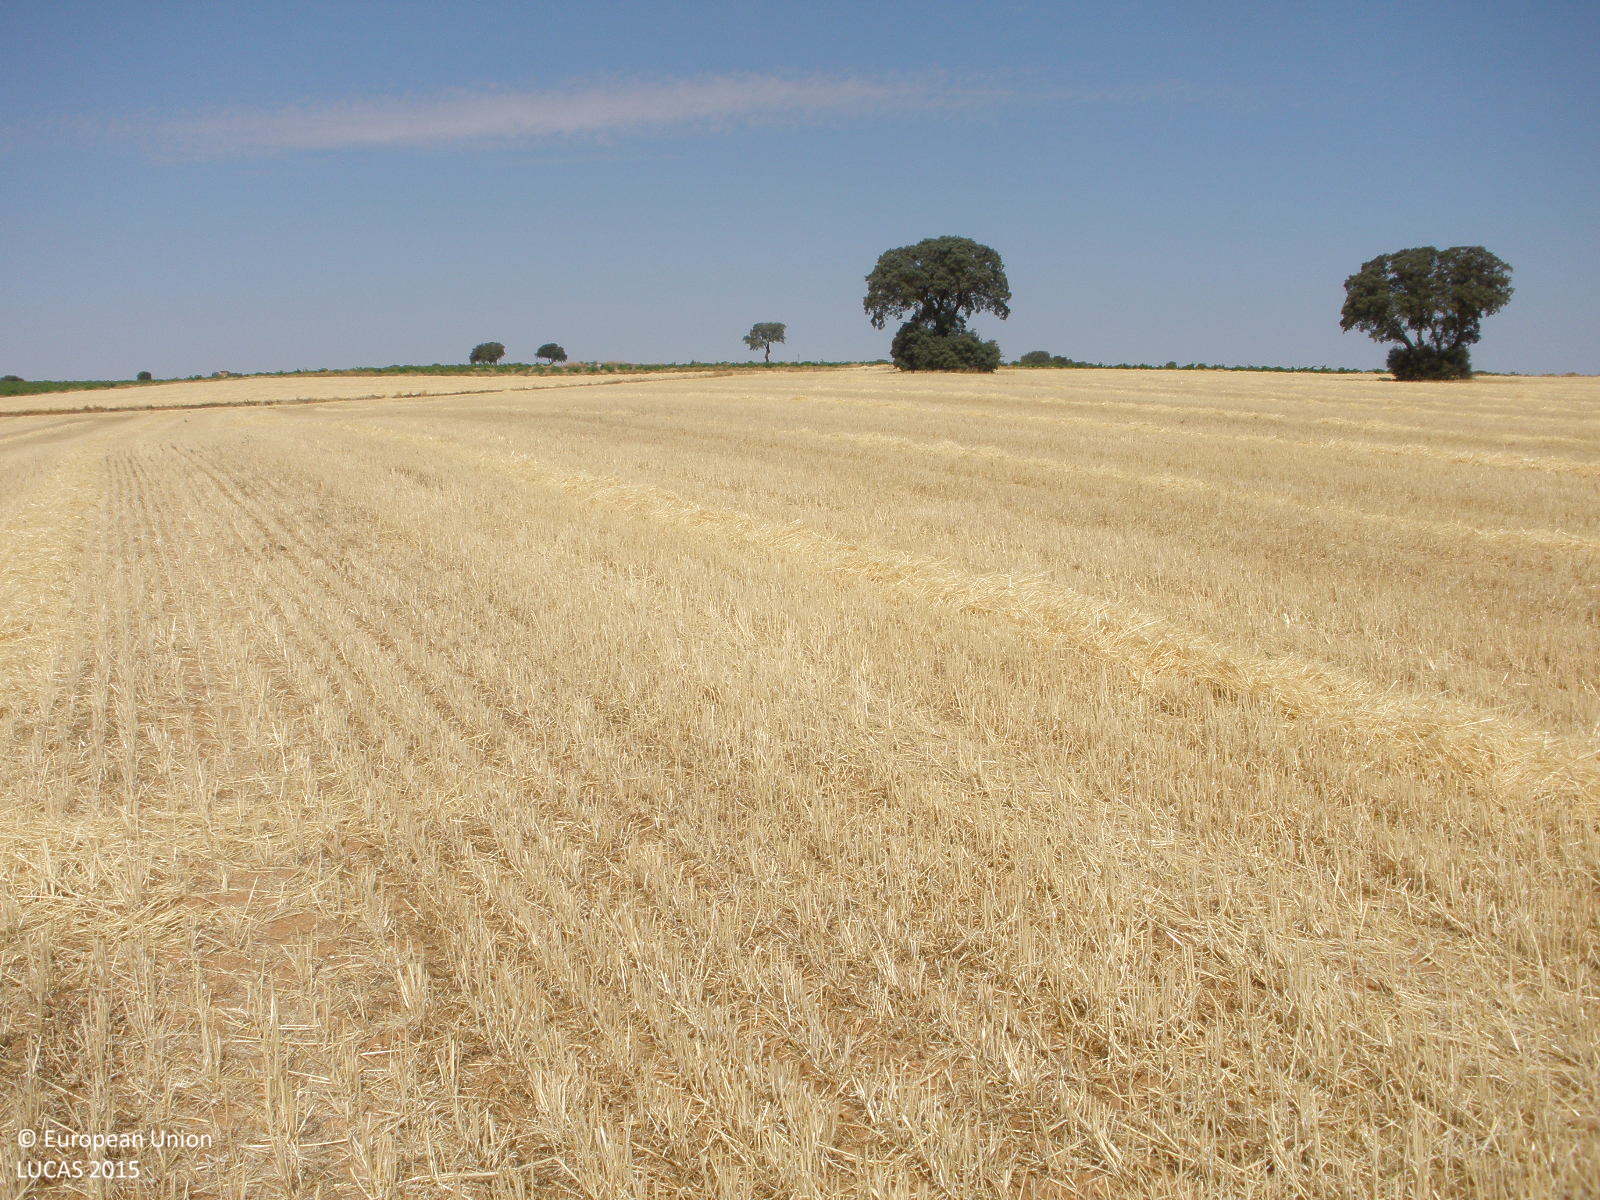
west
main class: Cropland
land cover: Barley
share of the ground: < 10 %
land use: Agriculture (excluding fallow land and kitchen gardens)
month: July
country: ES
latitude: 39.8749
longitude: -3.1301
